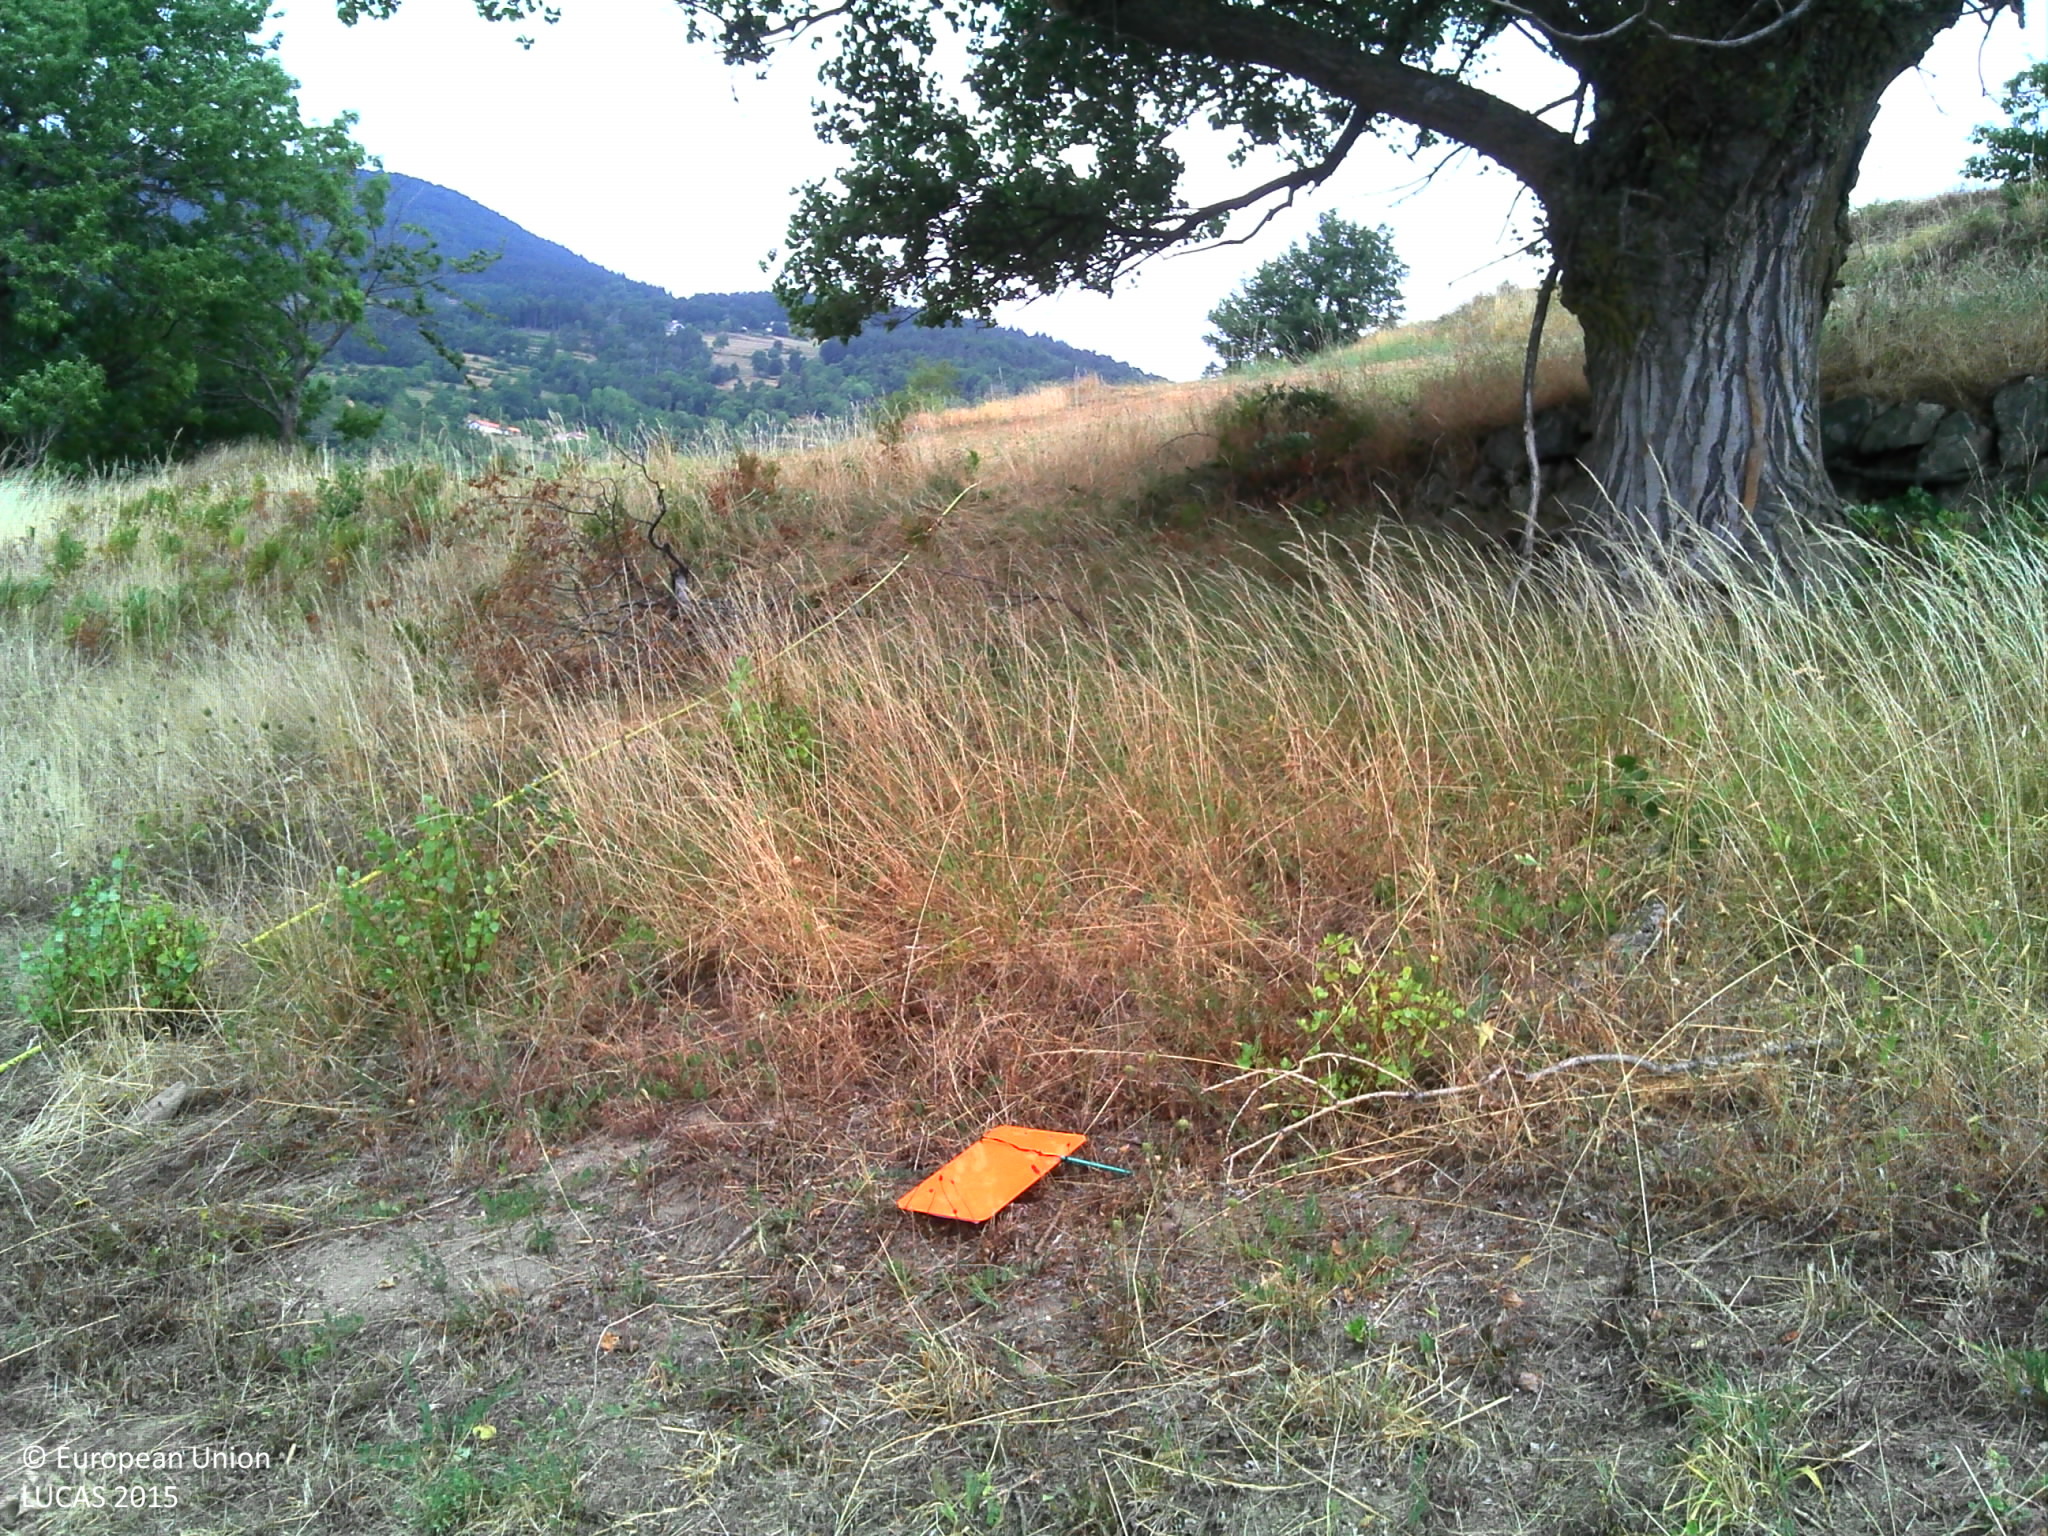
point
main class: Grassland
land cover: Grassland with sparse tree/shrub cover
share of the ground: > 75 %
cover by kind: herbaceous plants 95 %, broadleaved forest trees 5 %
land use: Agriculture (excluding fallow land and kitchen gardens)
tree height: > 5 m
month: August
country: FR
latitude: 45.3099
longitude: 4.5581
